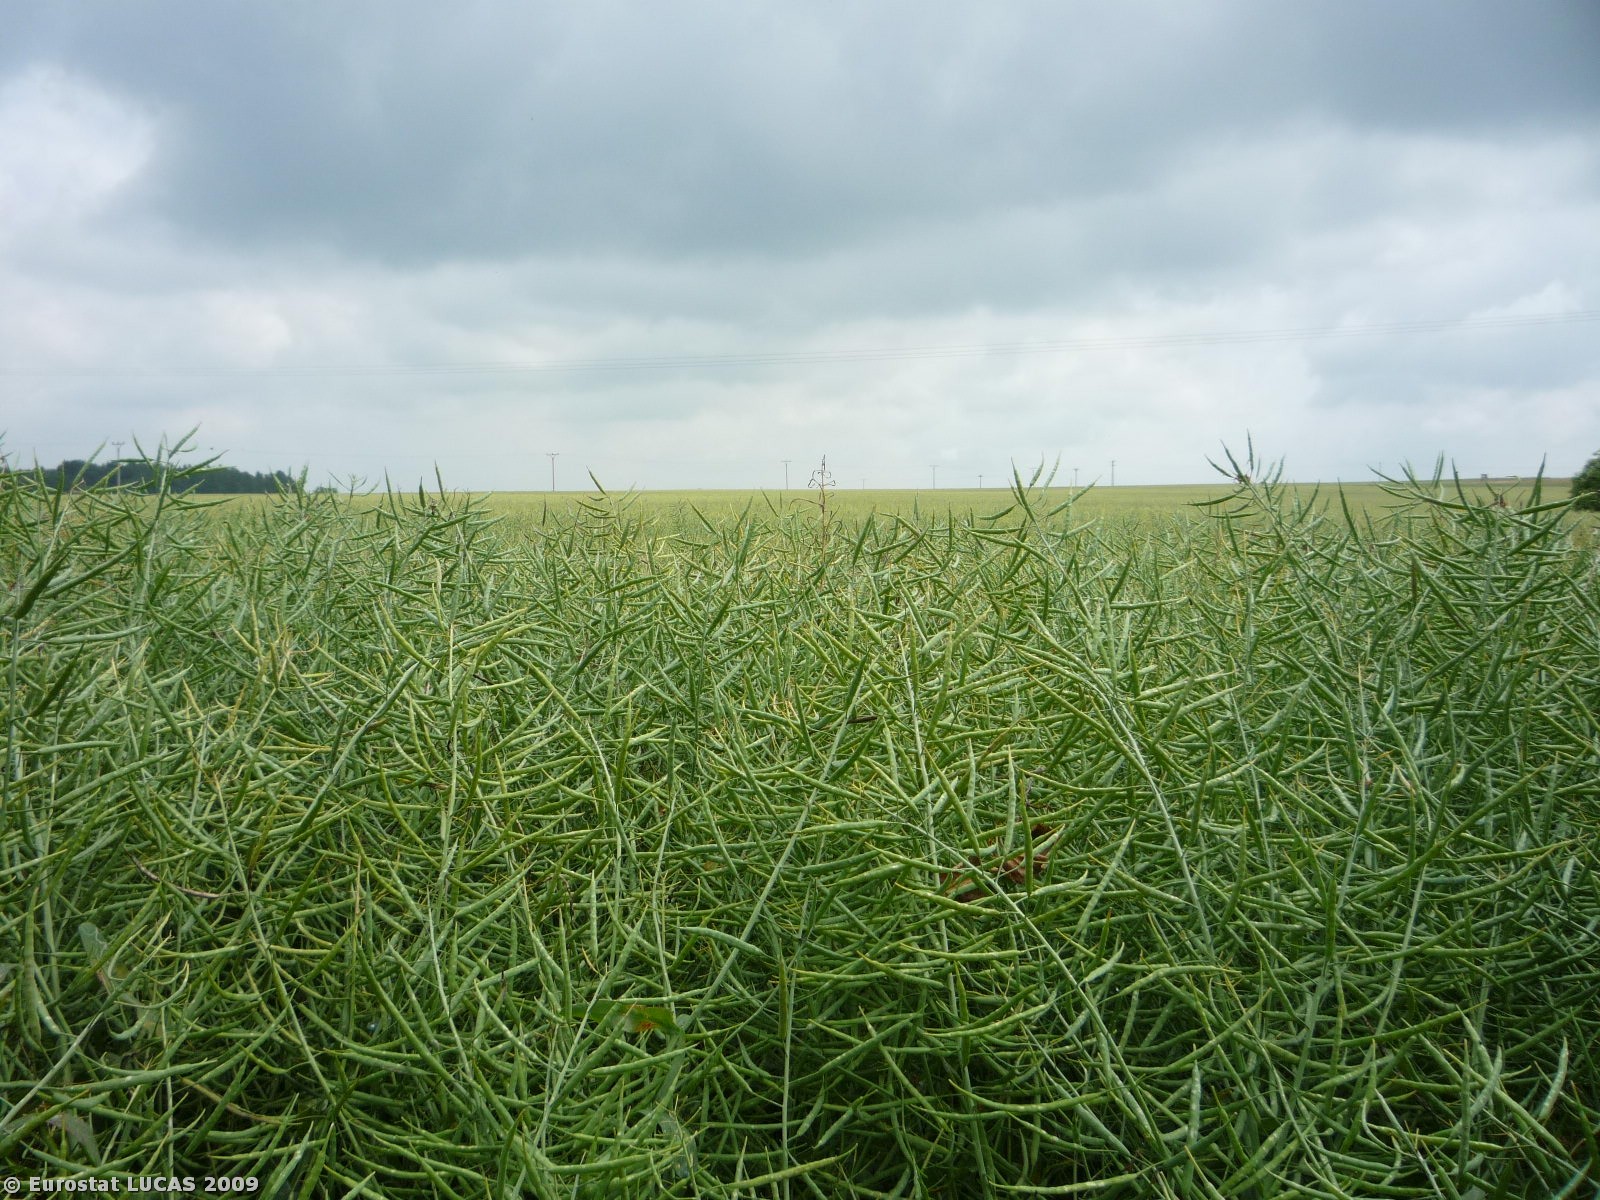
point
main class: Cropland
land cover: Rape and turnip rape
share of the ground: > 75 %
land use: Agriculture (excluding fallow land and kitchen gardens)
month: June
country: CZ
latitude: 49.9649
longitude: 15.0355
